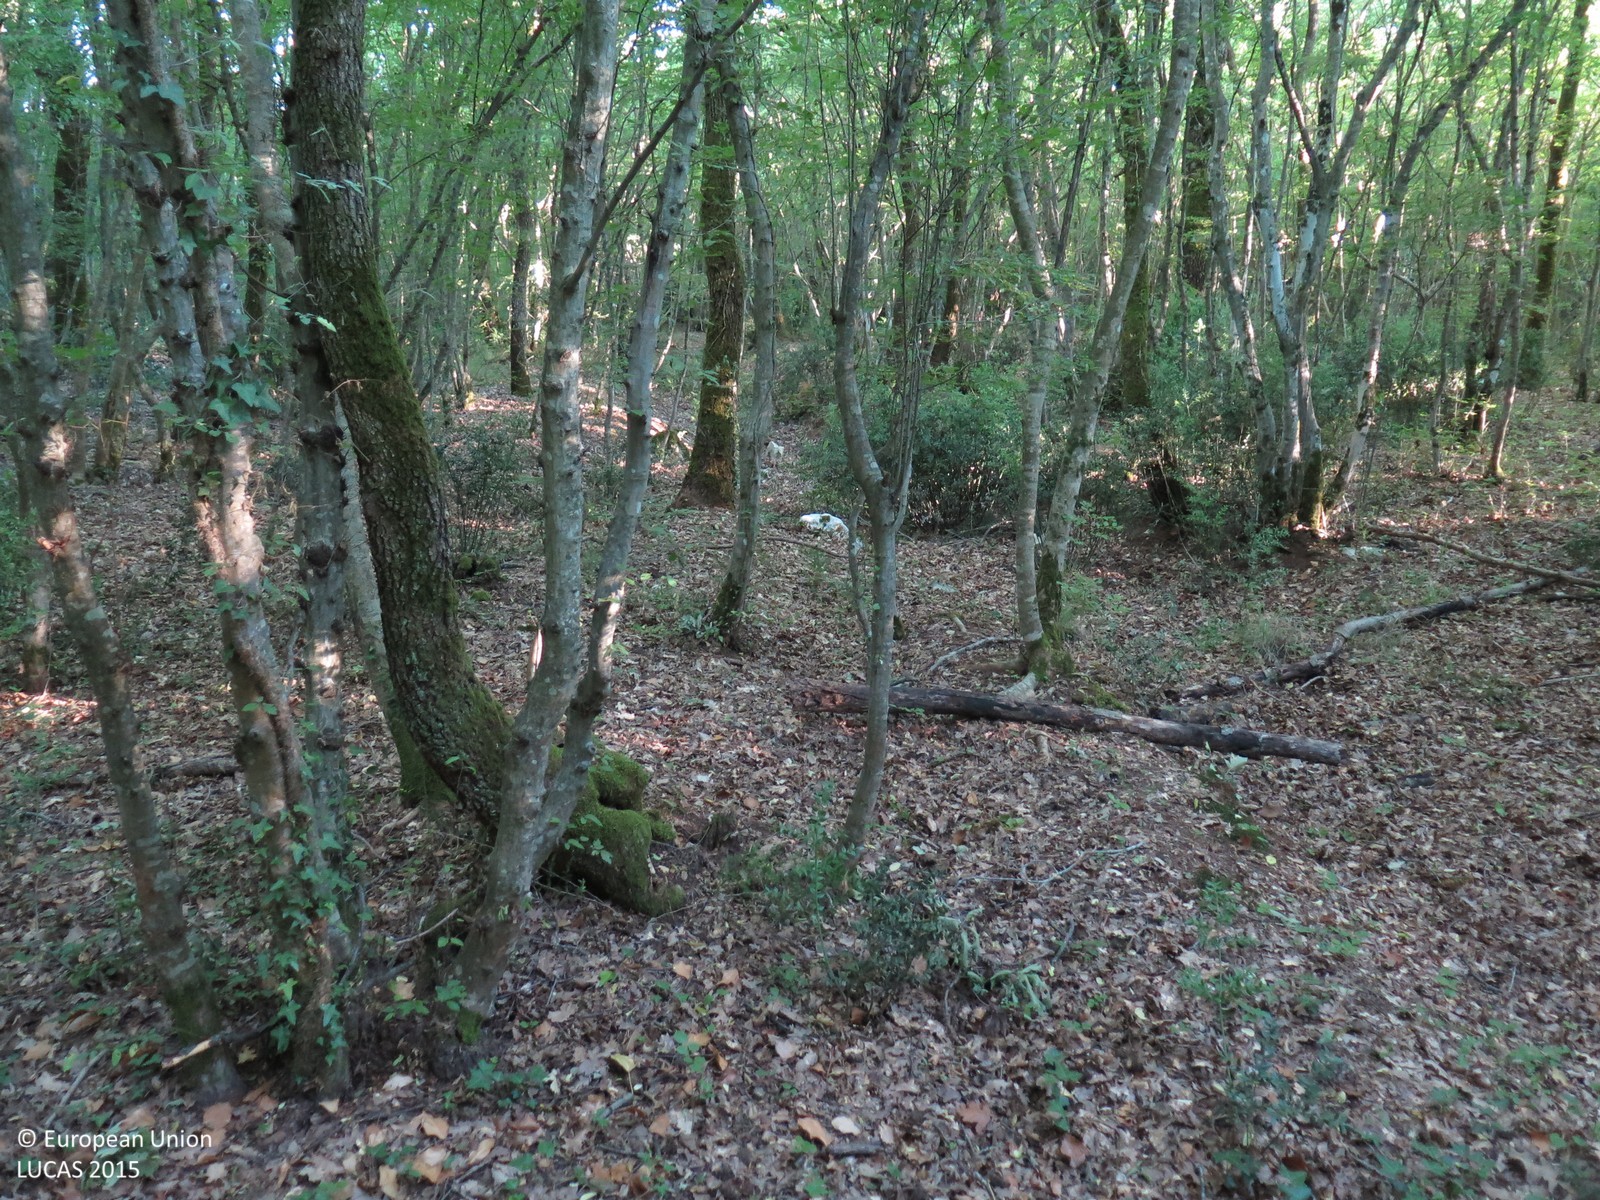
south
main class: Woodland
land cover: Broadleaved woodland
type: beech forest
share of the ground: > 75 %
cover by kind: broadleaved forest trees 100 %
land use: Semi-natural and natural areas not in use
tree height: > 5 m
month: June
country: HR
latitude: 45.1673
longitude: 13.7480
